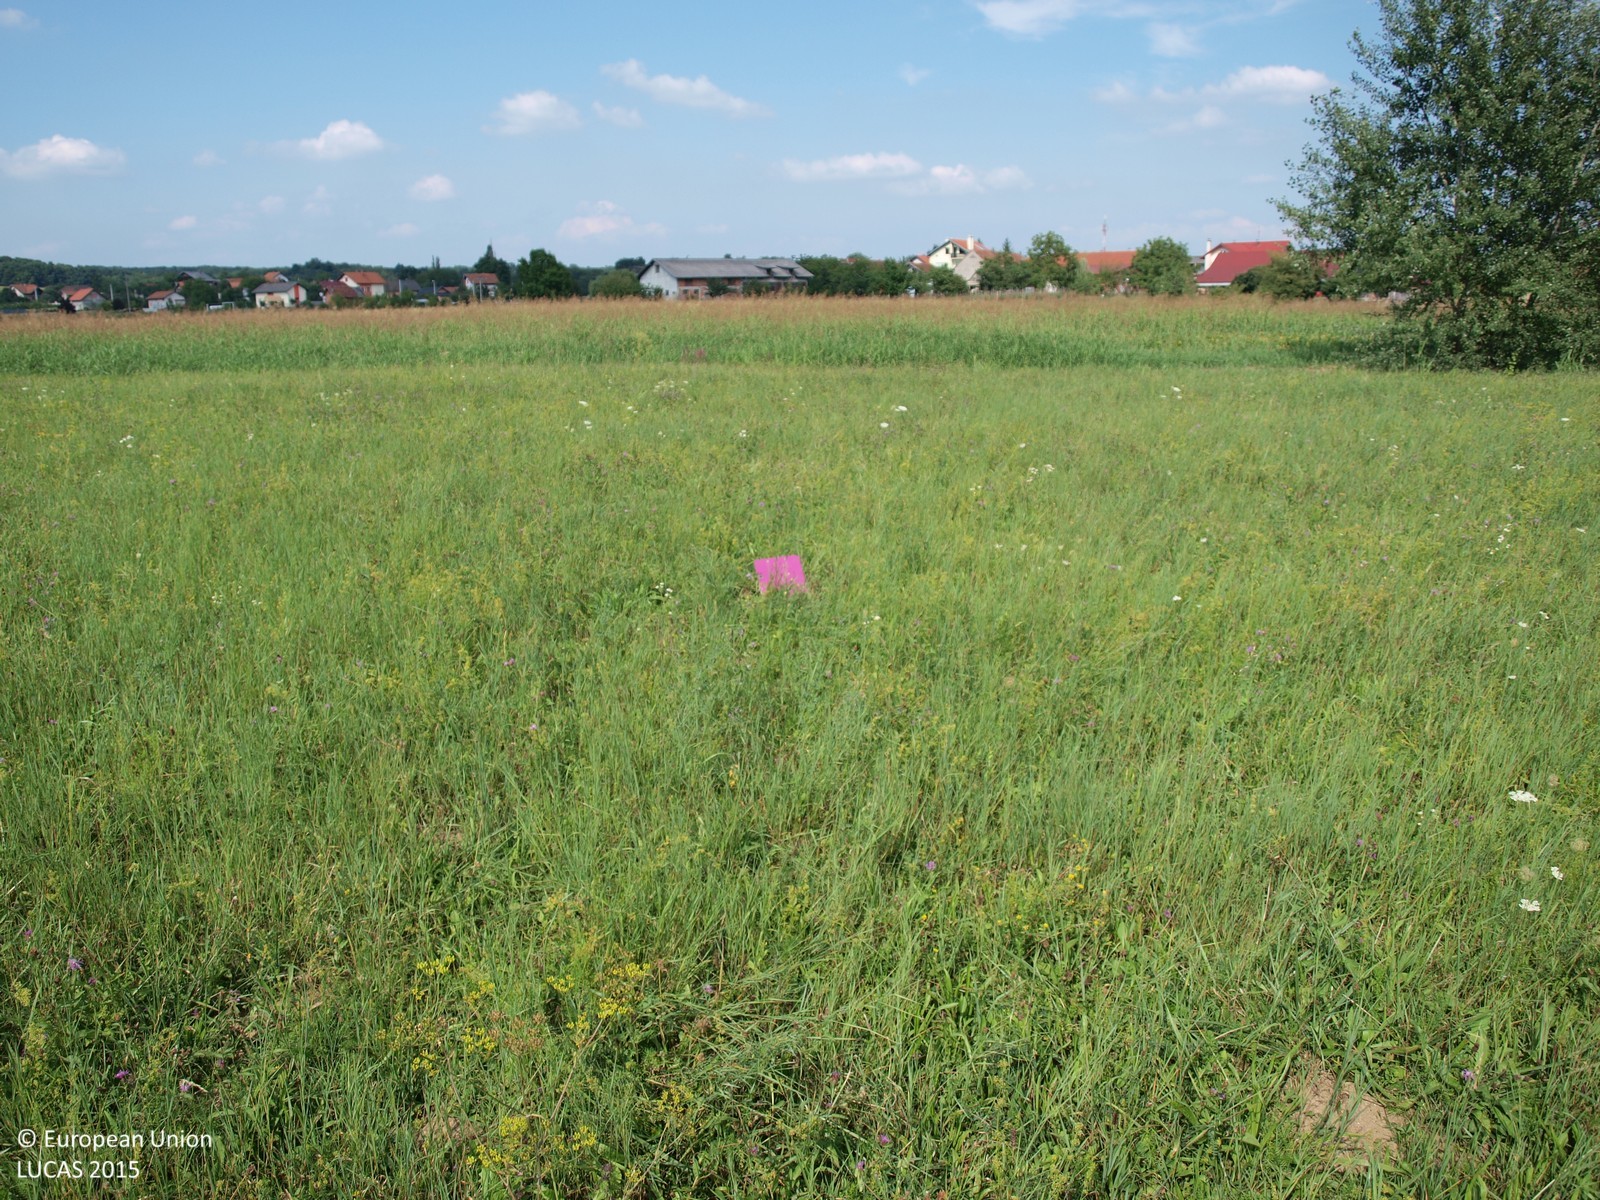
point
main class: Grassland
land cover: Grassland without tree/shrub cover
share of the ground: > 75 %
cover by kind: herbaceous plants 100 %
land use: Agriculture (excluding fallow land and kitchen gardens)
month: August
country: HR
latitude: 45.8840
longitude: 16.1707
